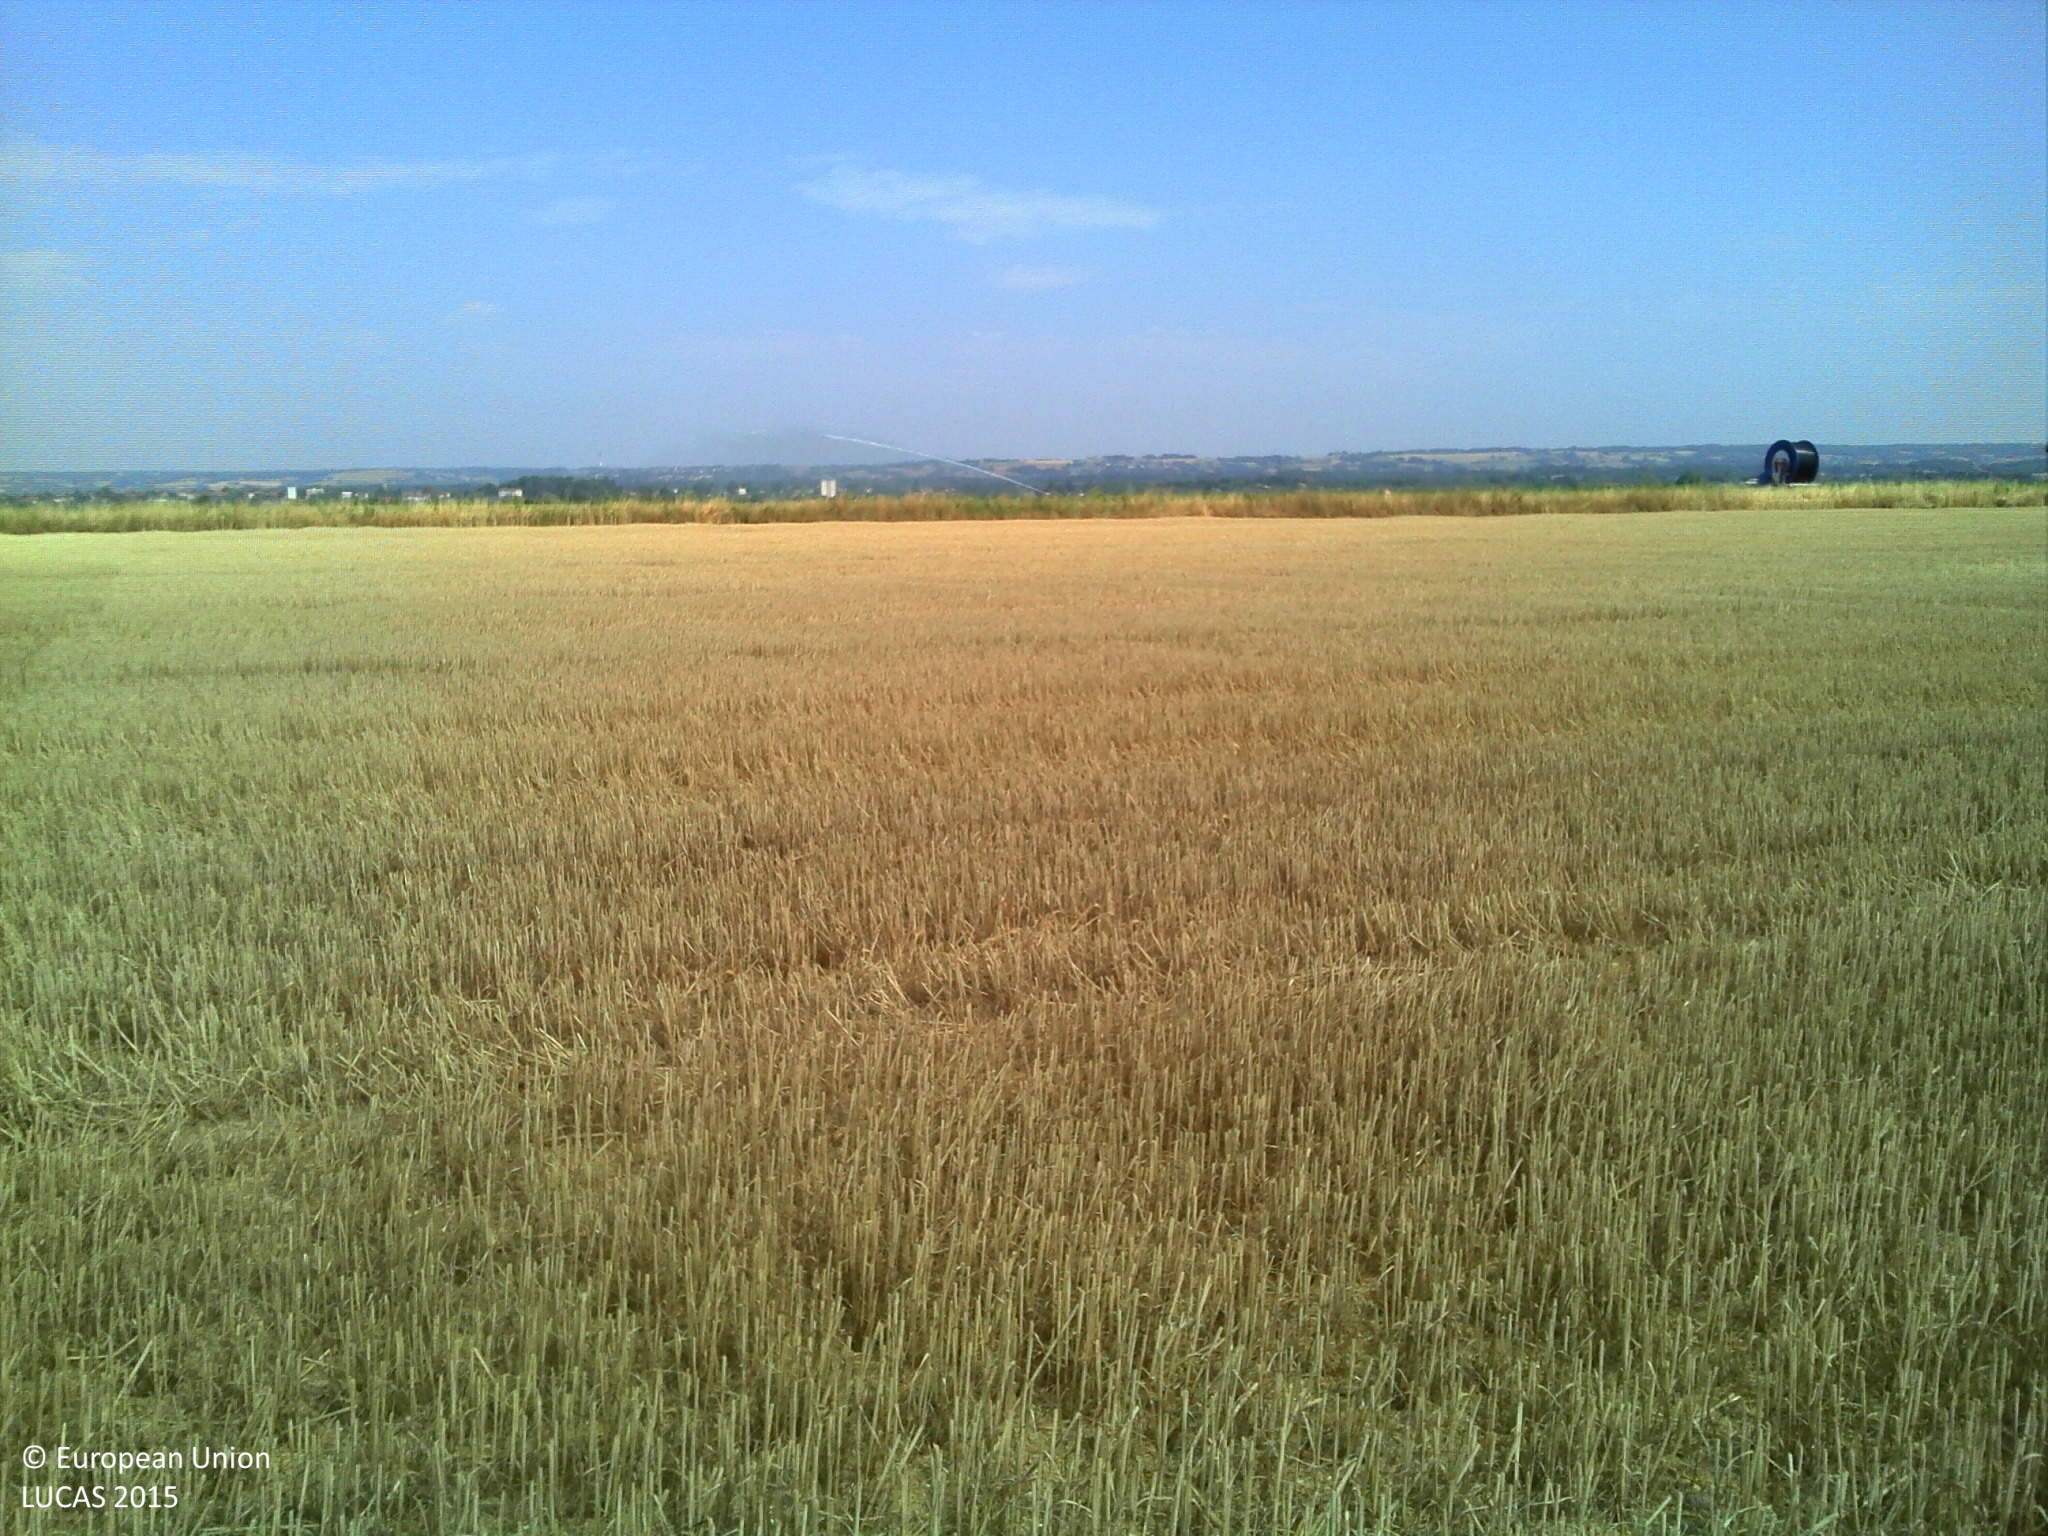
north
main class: Cropland
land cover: Durum wheat
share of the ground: > 75 %
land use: Agriculture (excluding fallow land and kitchen gardens)
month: July
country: FR
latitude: 45.3170
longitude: 5.0681
